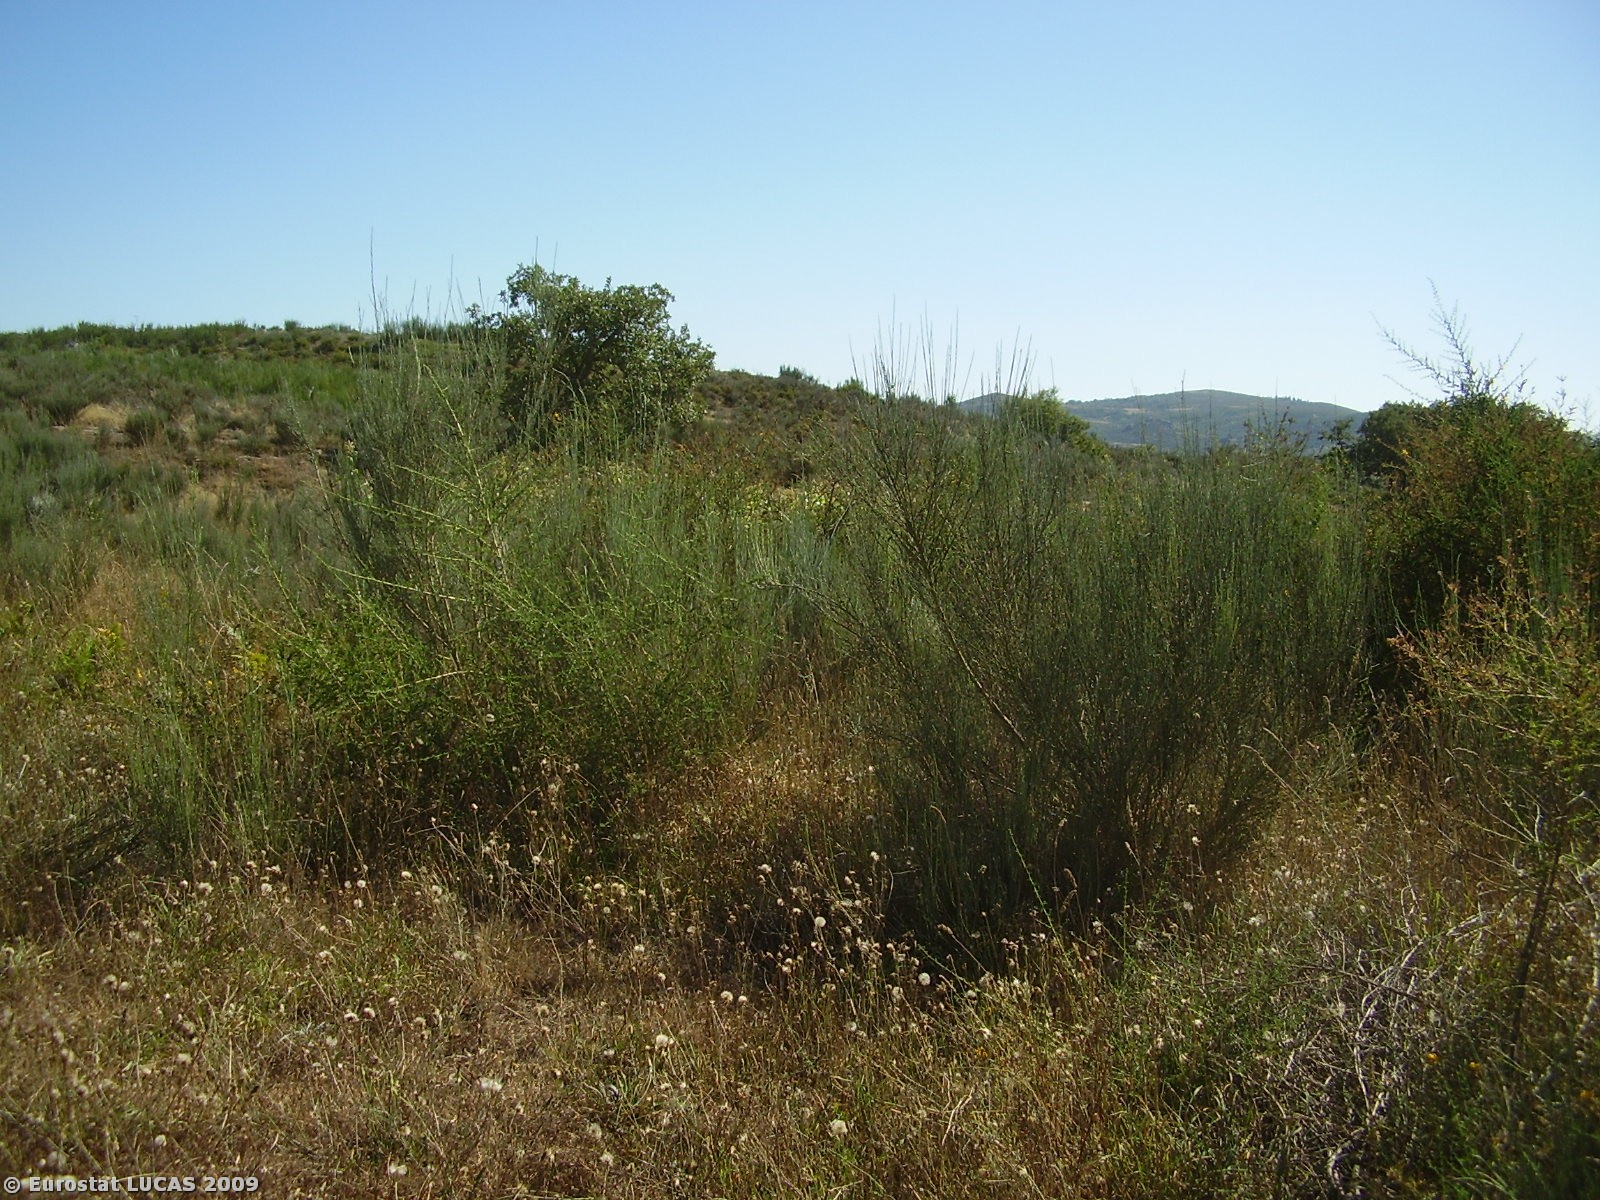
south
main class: Grassland
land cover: Spontaneously vegetated surfaces
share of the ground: > 75 %
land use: Fallow land
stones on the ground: 10 - 25 %
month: September
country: PT
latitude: 41.8089
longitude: -7.6496
